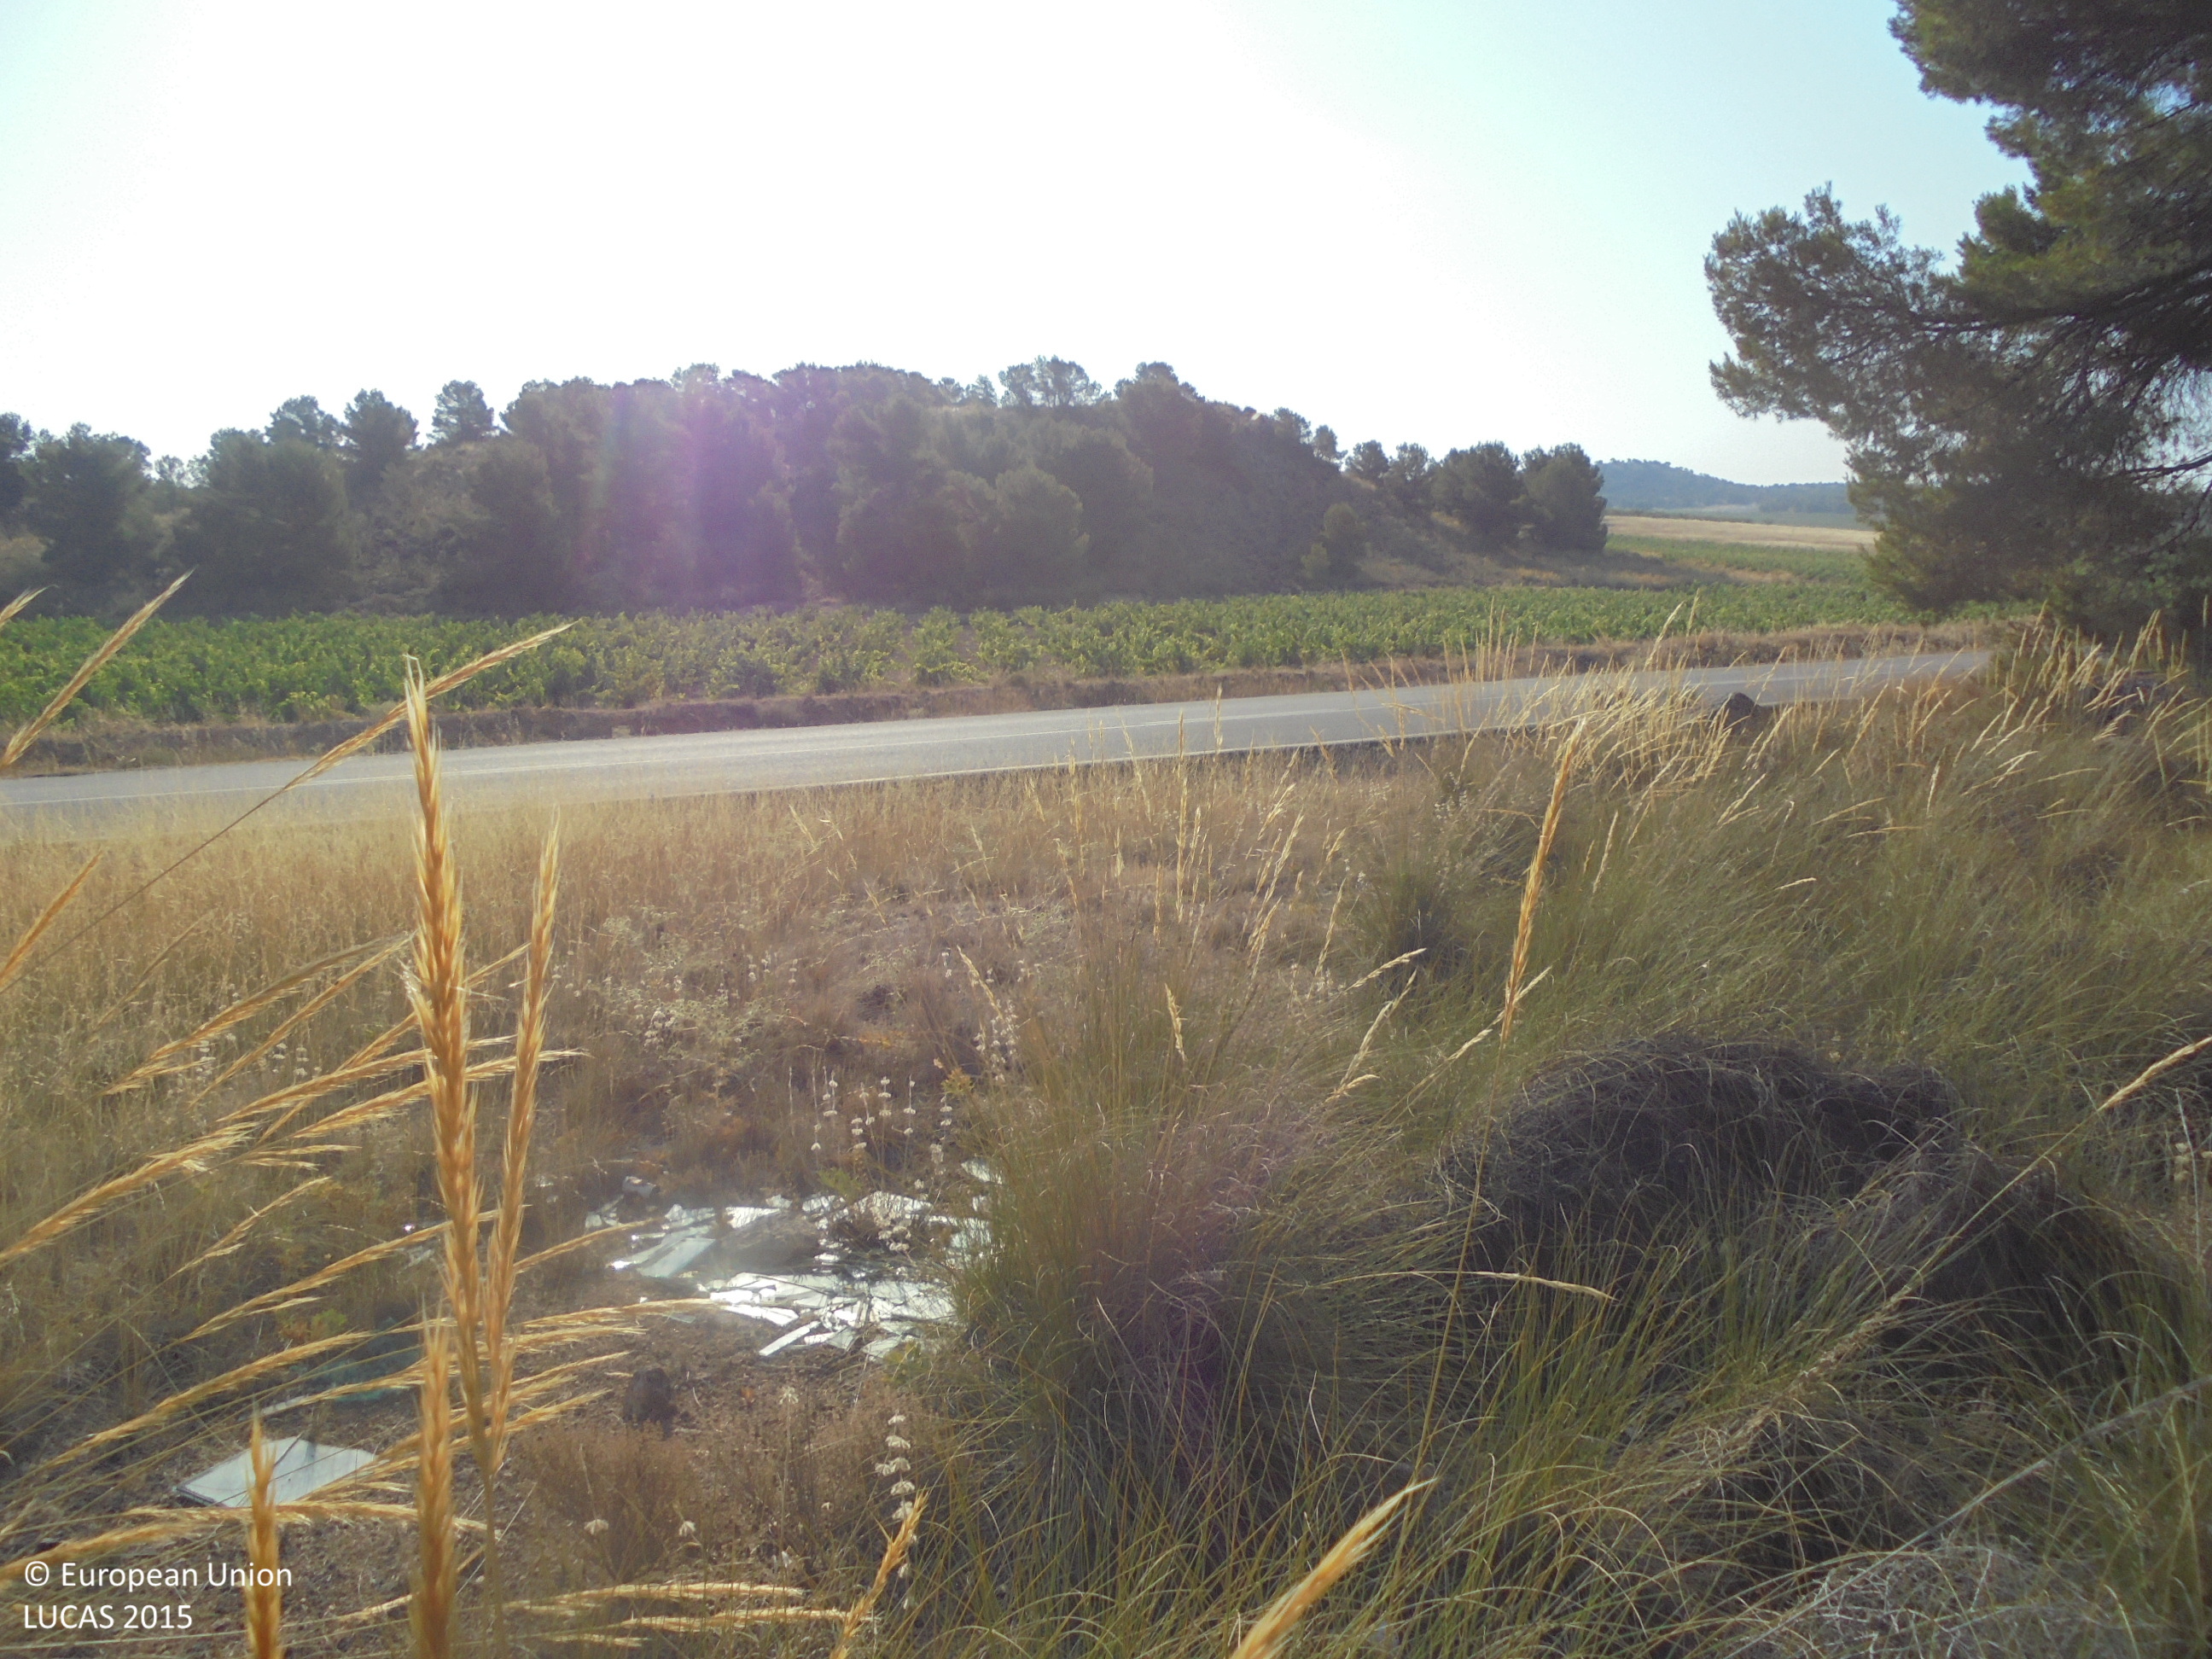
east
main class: Woodland
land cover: Pine dominated coniferous woodland
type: coniferous forest of the mediterranean region
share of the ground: 25 - 50 %
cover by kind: coniferous forest trees 45 %, shrubs 40 %, unconsolidated bare surface 15 %
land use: Semi-natural and natural areas not in use
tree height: > 5 m
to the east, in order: Pine dominated coniferous woodland; Shrubland with sparse tree cover; Paved roads, cycling and walking lanes; Grassland without tree/shrub cover; Dry stone walls; Other bare soil; Shrubland without tree cover; Vineyards; Pine dominated coniferous woodland; Shrubland with sparse tree cover
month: July
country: ES
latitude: 38.5293
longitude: -1.4978
